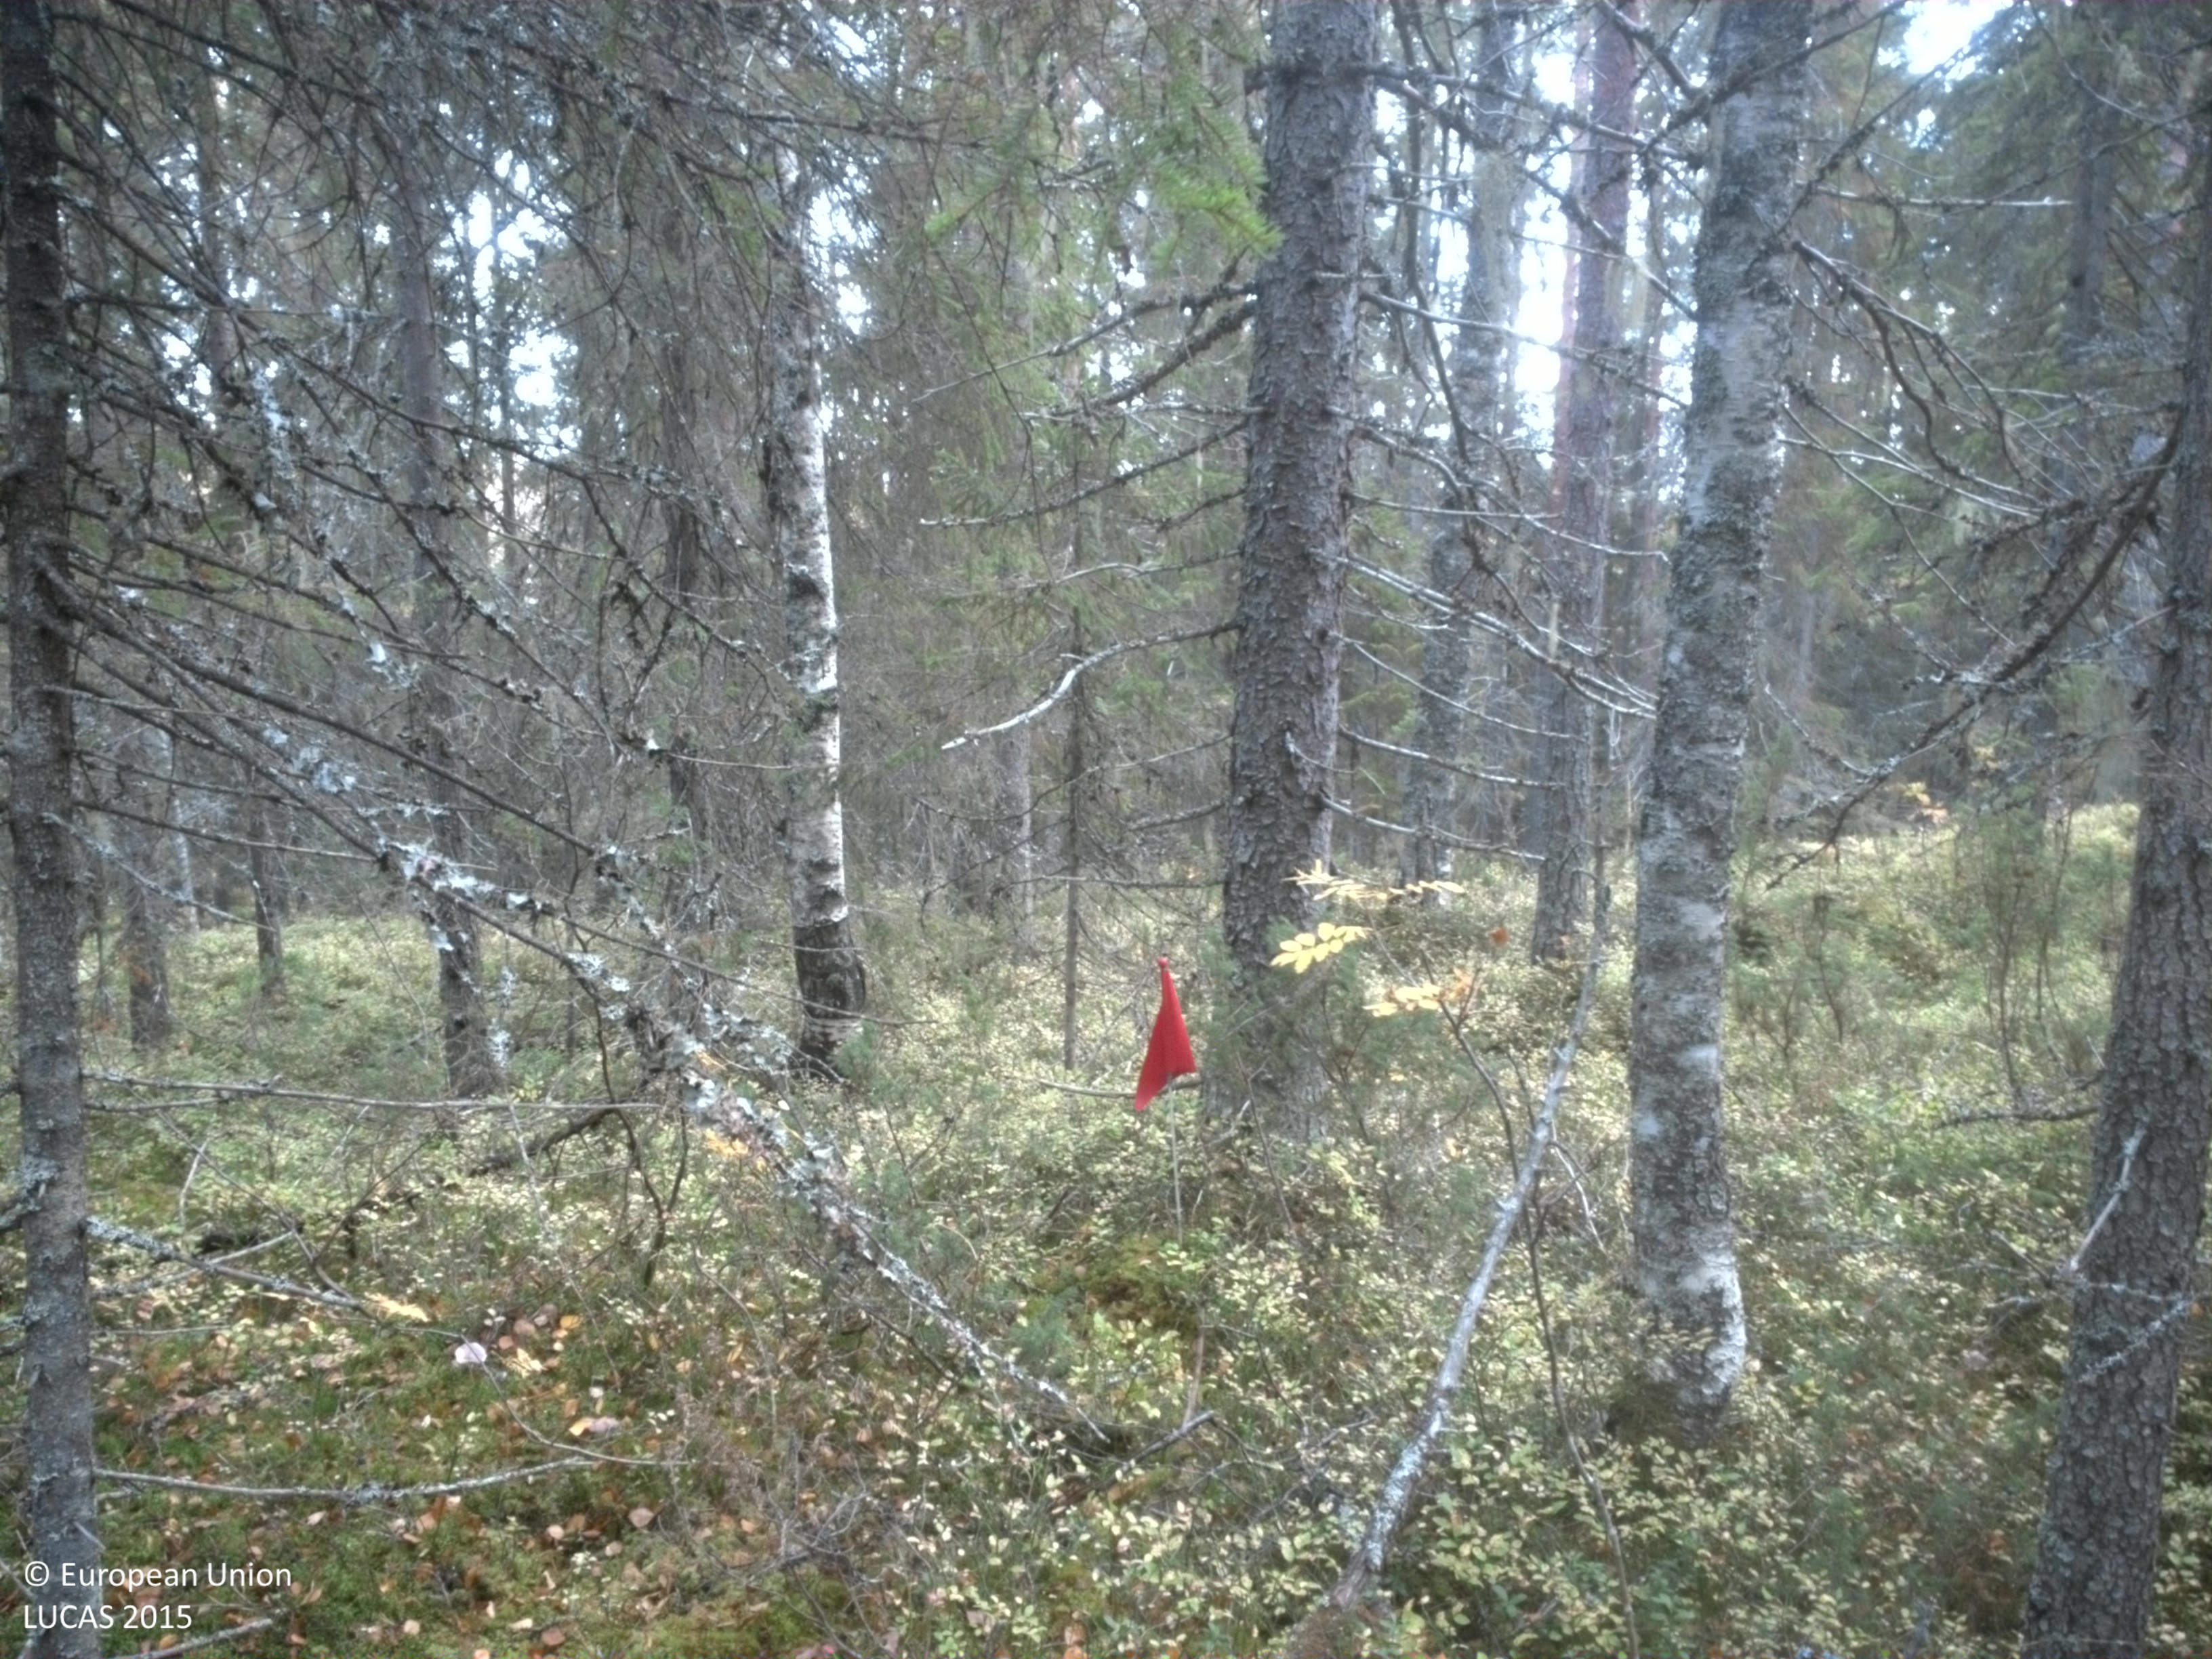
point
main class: Woodland
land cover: Spruce dominated coniferous woodland
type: boreal forest
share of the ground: 50 - 75 %
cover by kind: coniferous forest trees 60 %, shrubs 30 %, broadleaved forest trees 5 %, lichens and mosses 5 %
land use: Forestry
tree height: > 5 m
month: October
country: SE
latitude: 64.0433
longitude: 20.0329
